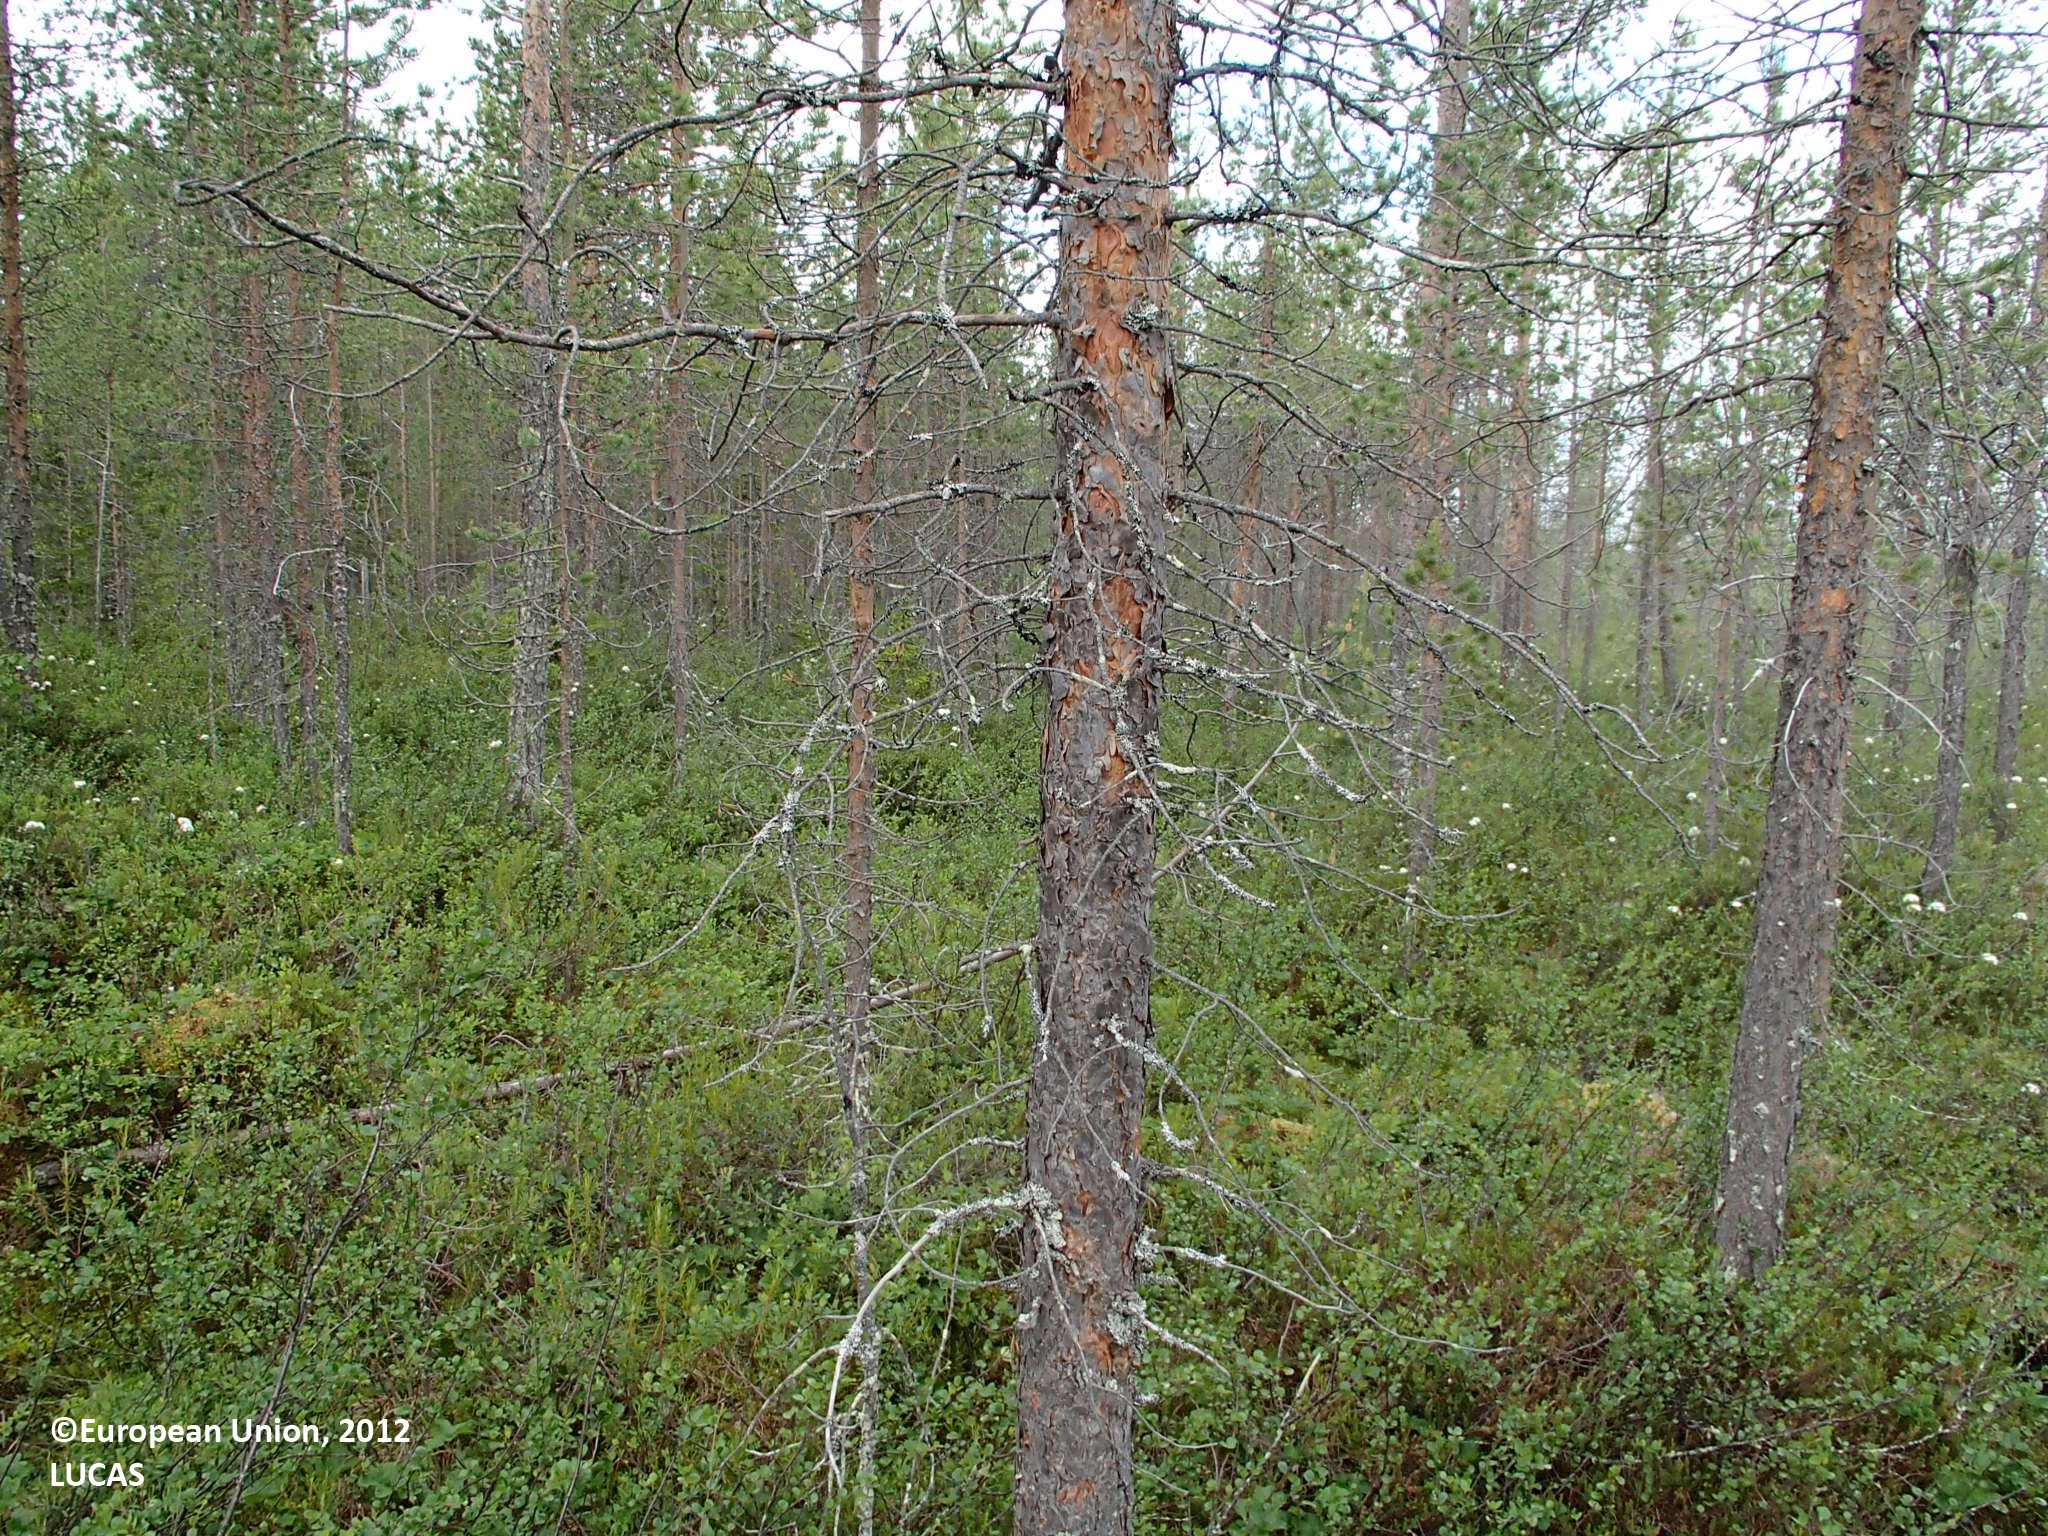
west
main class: Woodland
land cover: Pine dominated coniferous woodland
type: boreal forest
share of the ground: > 75 %
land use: Forestry
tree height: > 5 m
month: July
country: FI
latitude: 66.9022
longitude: 28.0091
